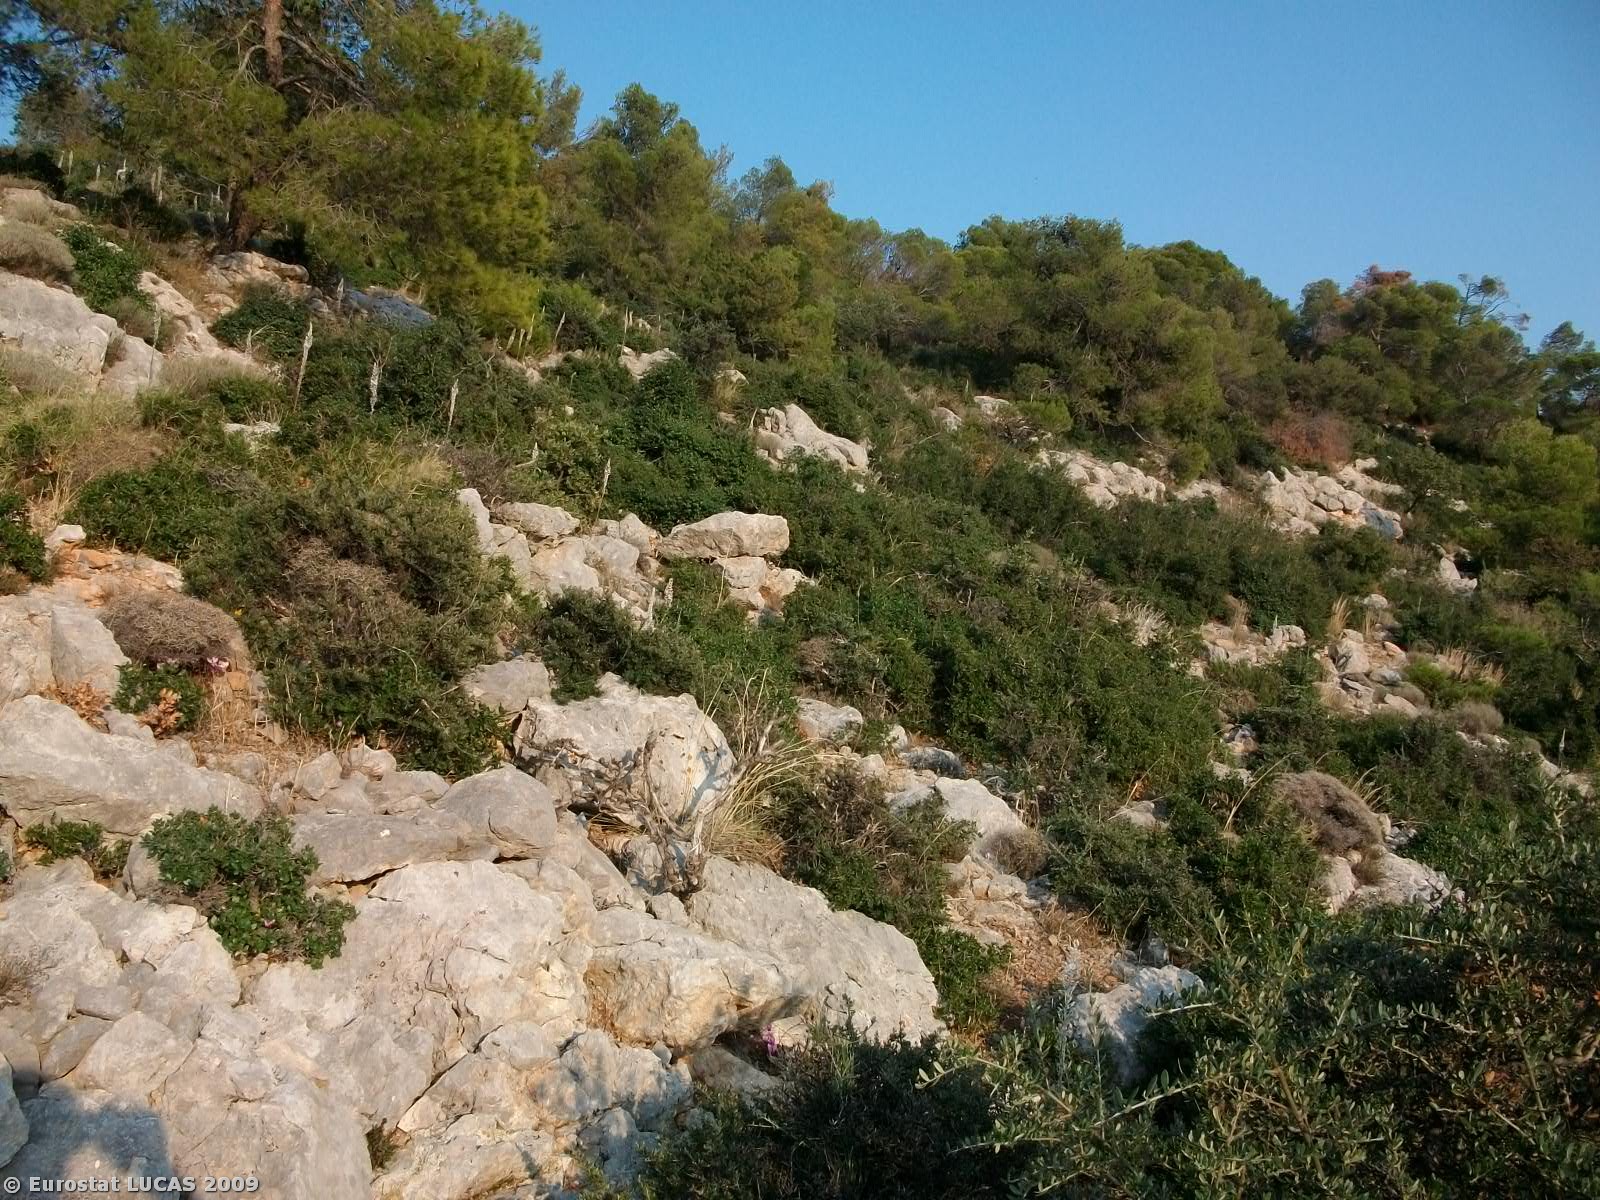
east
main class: Shrubland
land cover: Shrubland with sparse tree cover
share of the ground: 50 - 75 %
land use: Agriculture (excluding fallow land and kitchen gardens)
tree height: < 5 m
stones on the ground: 10 - 25 %
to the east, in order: Shrubland with sparse tree cover; Coniferous woodland; Shrubland without tree cover
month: September
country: GR
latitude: 38.1087
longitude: 23.4485
